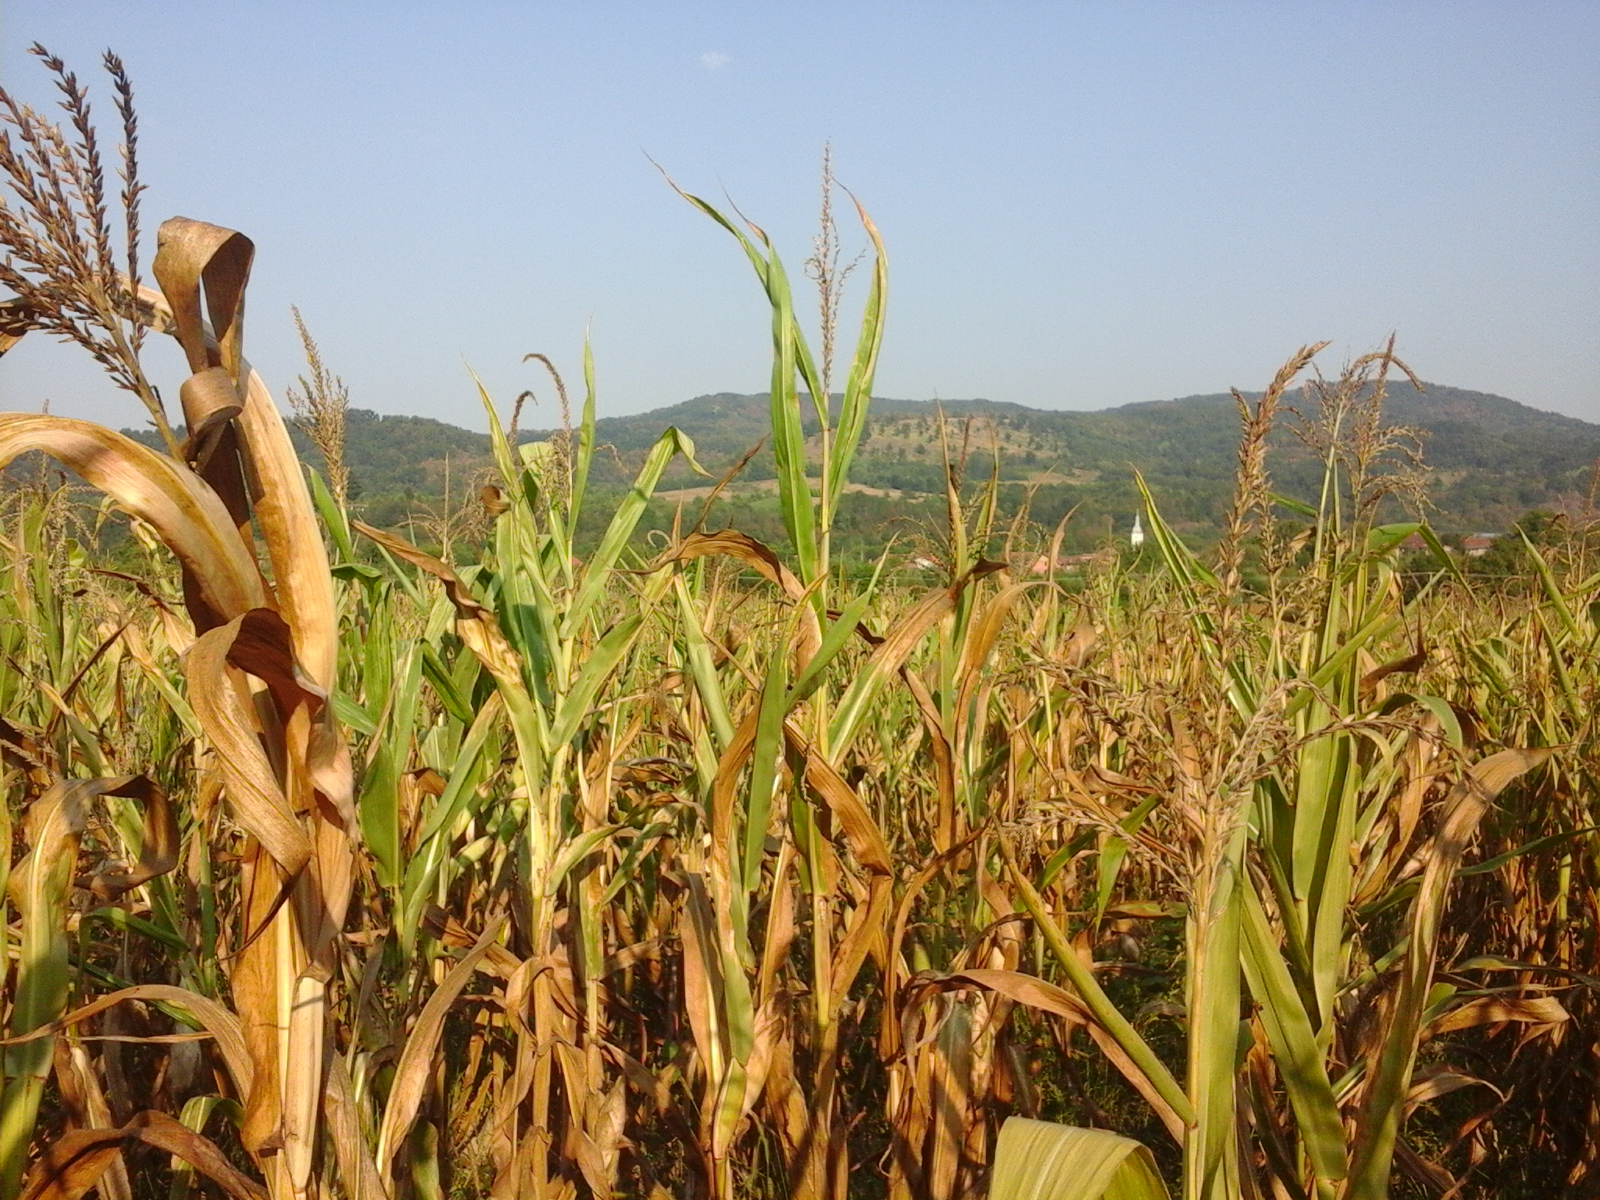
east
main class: Cropland
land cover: Maize
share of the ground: > 75 %
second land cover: Spontaneously vegetated surfaces
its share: 10 - 25 %
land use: Agriculture (excluding fallow land and kitchen gardens)
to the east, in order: Maize; Spontaneously vegetated surfaces; Maize; Grass margins; Ditches and canals; Grass margins; Tracks; Grass margins; Ditches and canals; Grass margins; Electric lines; Maize
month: August
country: RO
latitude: 46.2537
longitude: 22.3319
